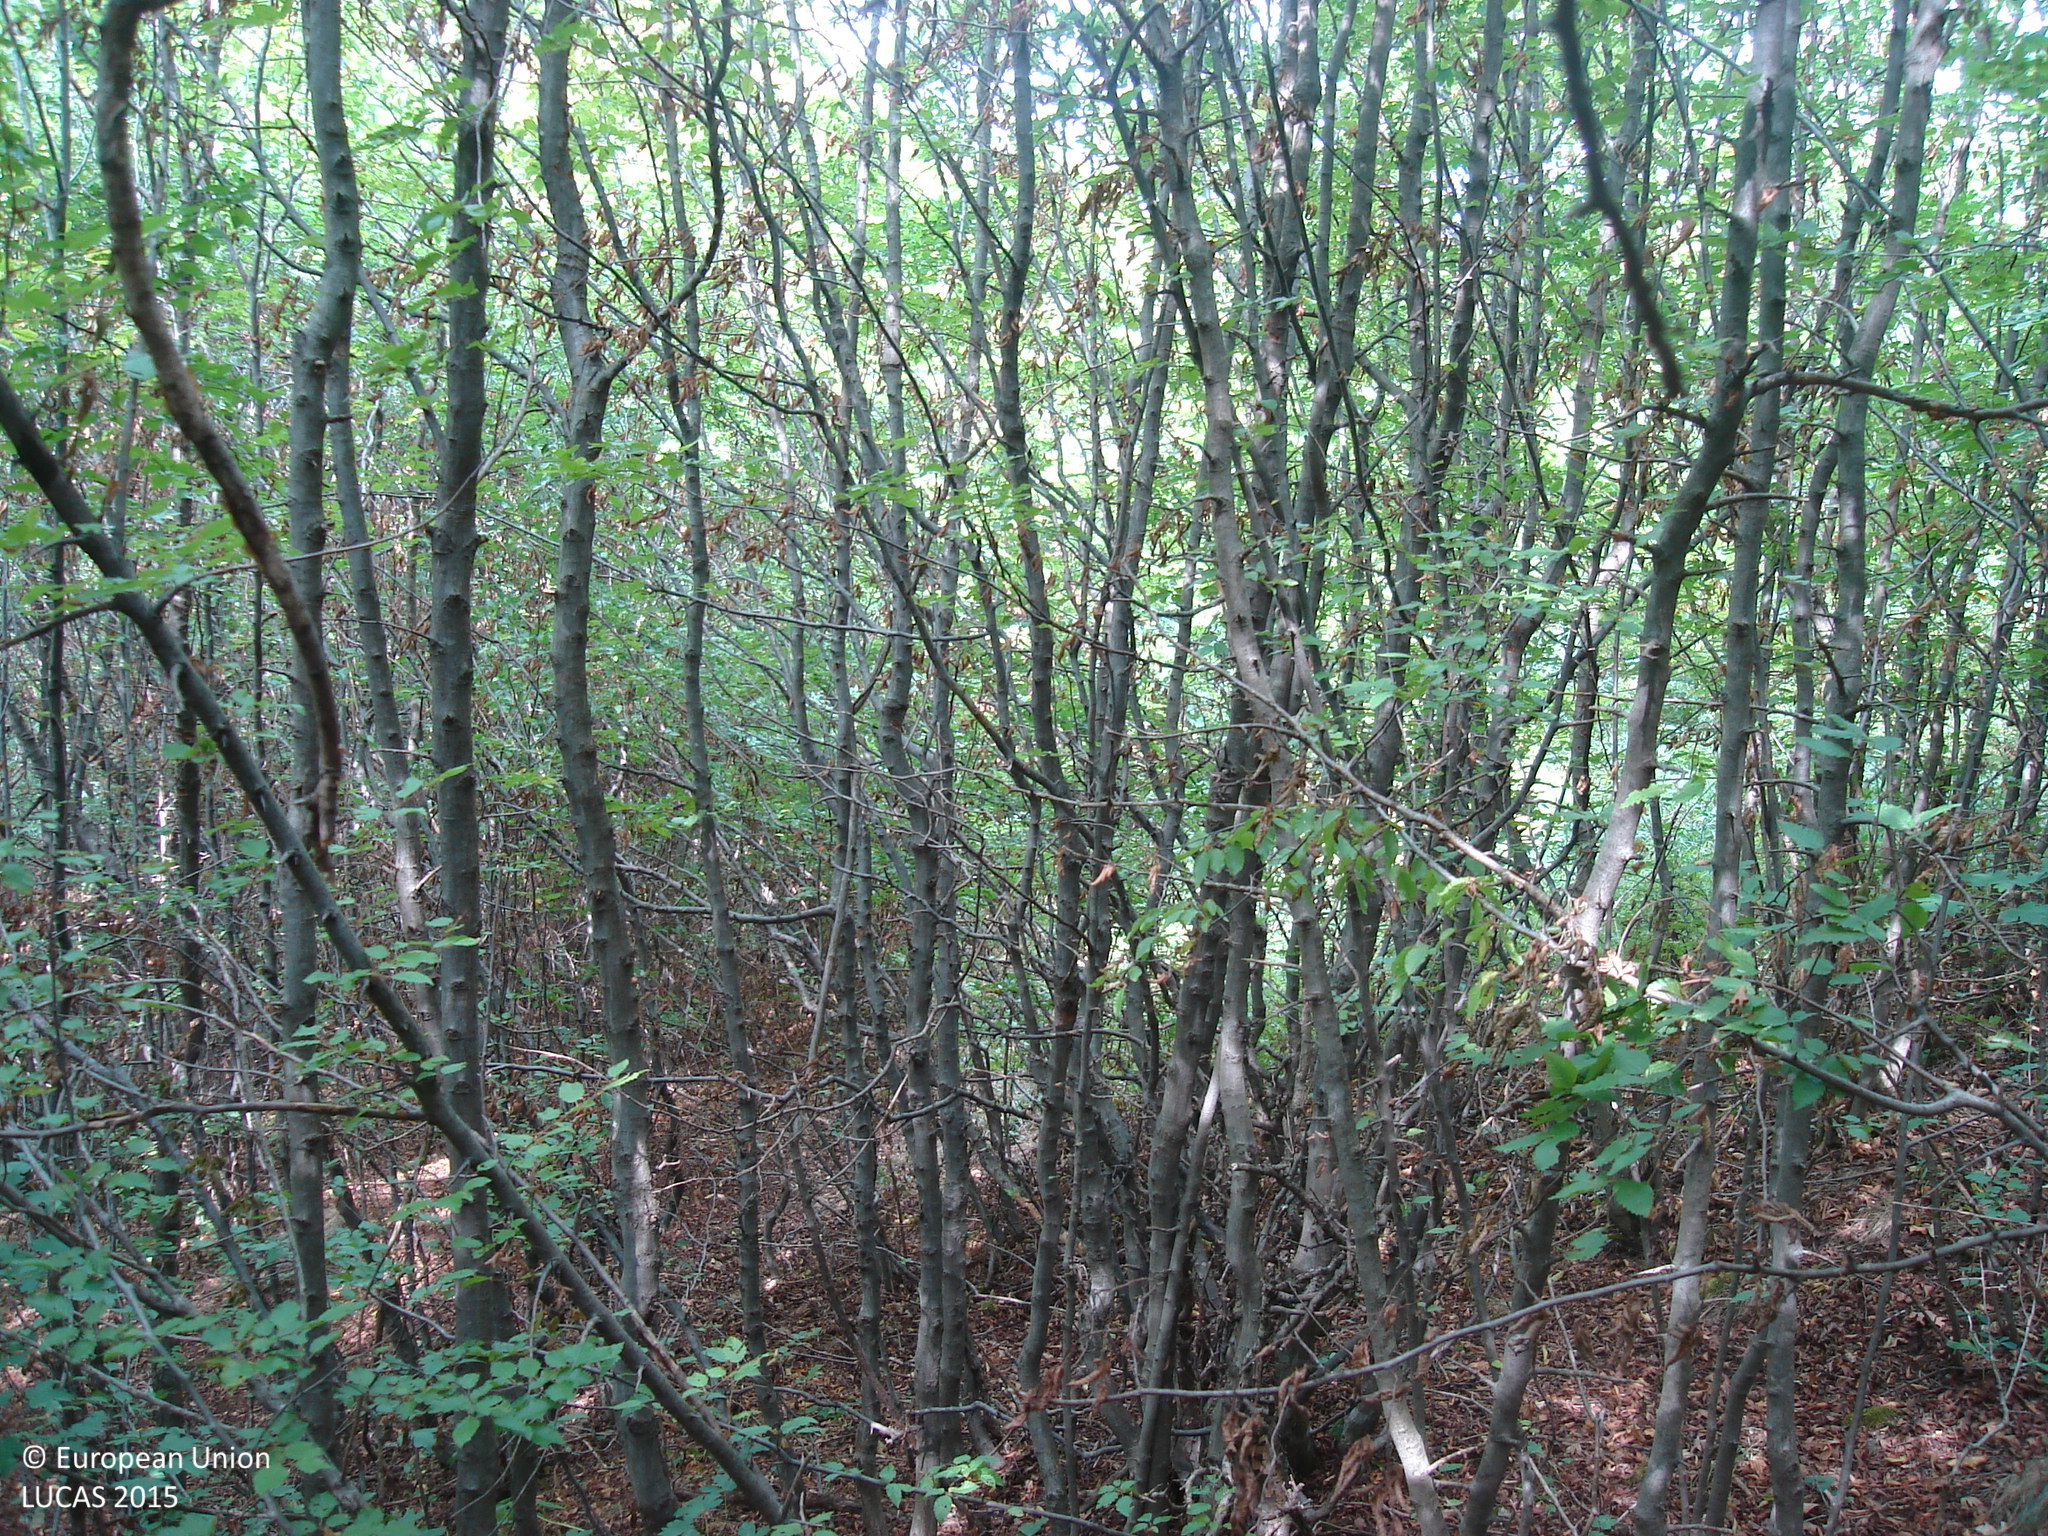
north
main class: Woodland
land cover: Broadleaved woodland
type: mesophytic deciduous forest
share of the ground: > 75 %
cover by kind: broadleaved forest trees 95 %, consolidated bare surface 5 %
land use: Forestry
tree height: < 5 m
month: September
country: BG
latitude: 43.1151
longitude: 23.3734
